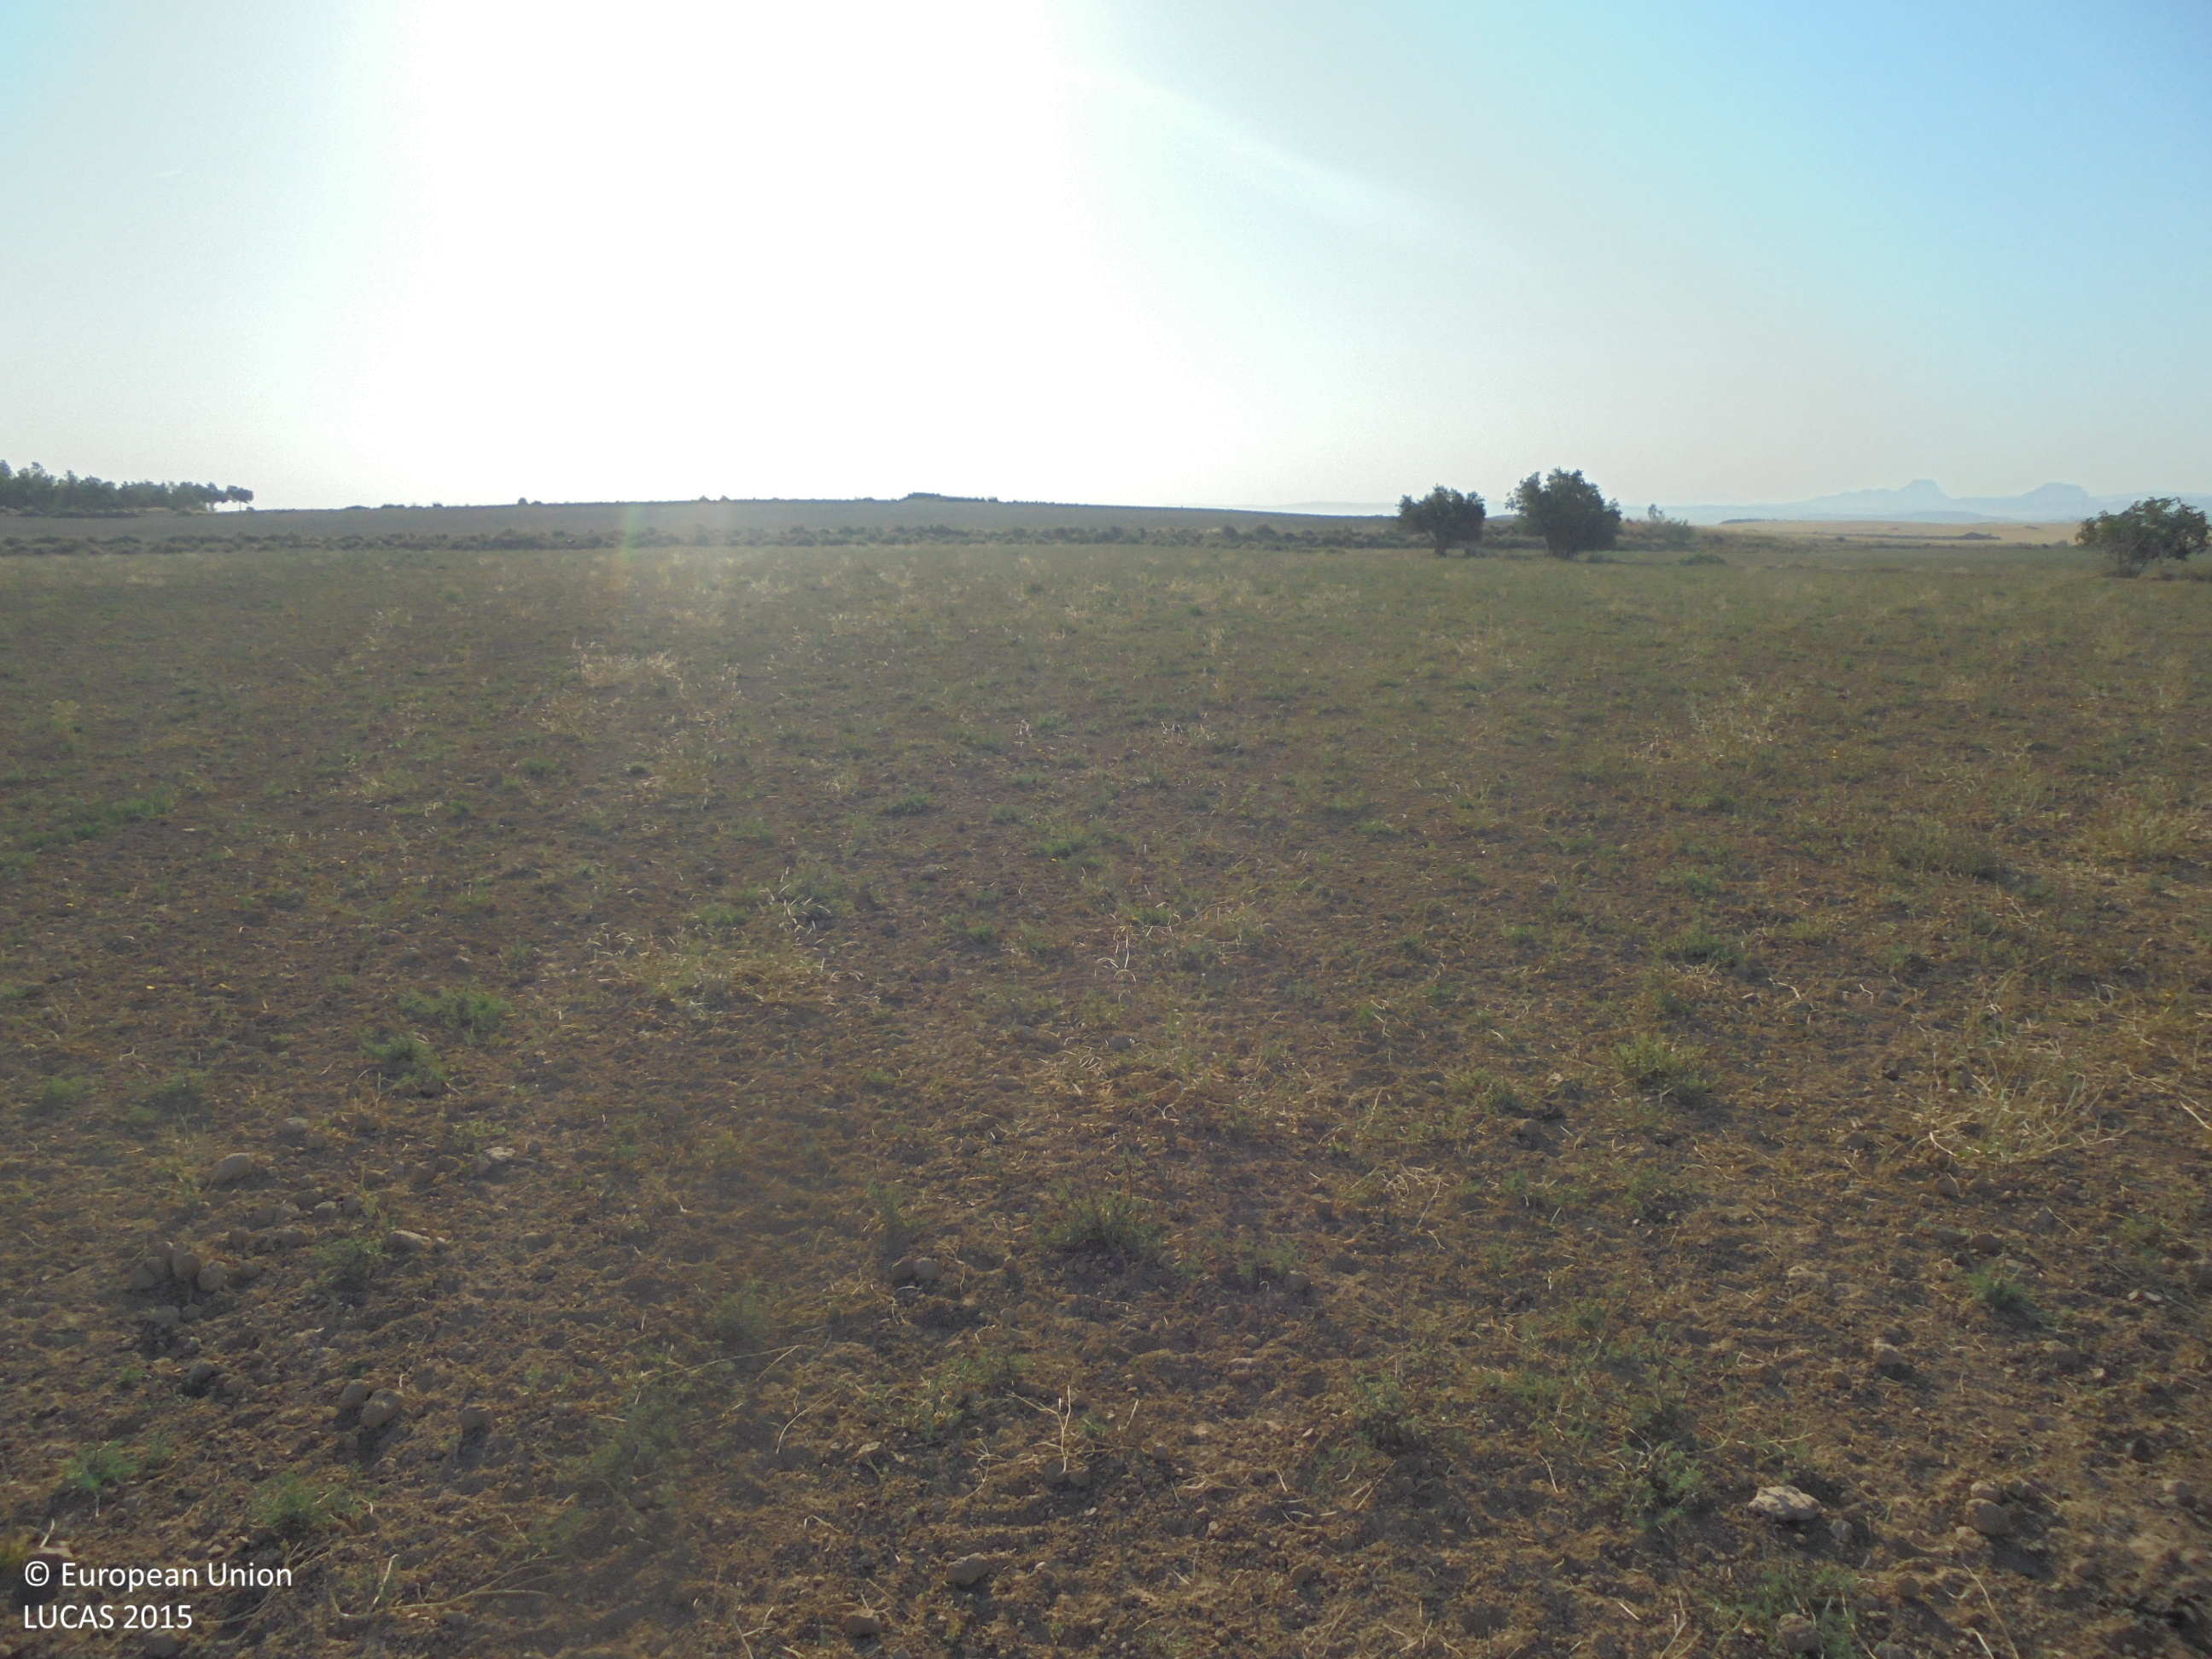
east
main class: Grassland
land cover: Spontaneously vegetated surfaces
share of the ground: 10 - 25 %
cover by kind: unconsolidated bare surface 80 %, herbaceous plants 20 %
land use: Agriculture (excluding fallow land and kitchen gardens)
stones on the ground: 10 - 25 %
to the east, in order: Spontaneously vegetated surfaces; Grass margins; Spontaneously vegetated surfaces; Shrubland without tree cover; Spontaneously vegetated surfaces; Grass margins; Tracks; Grass margins; Other bare soil
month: July
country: ES
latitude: 38.5487
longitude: -1.6397
